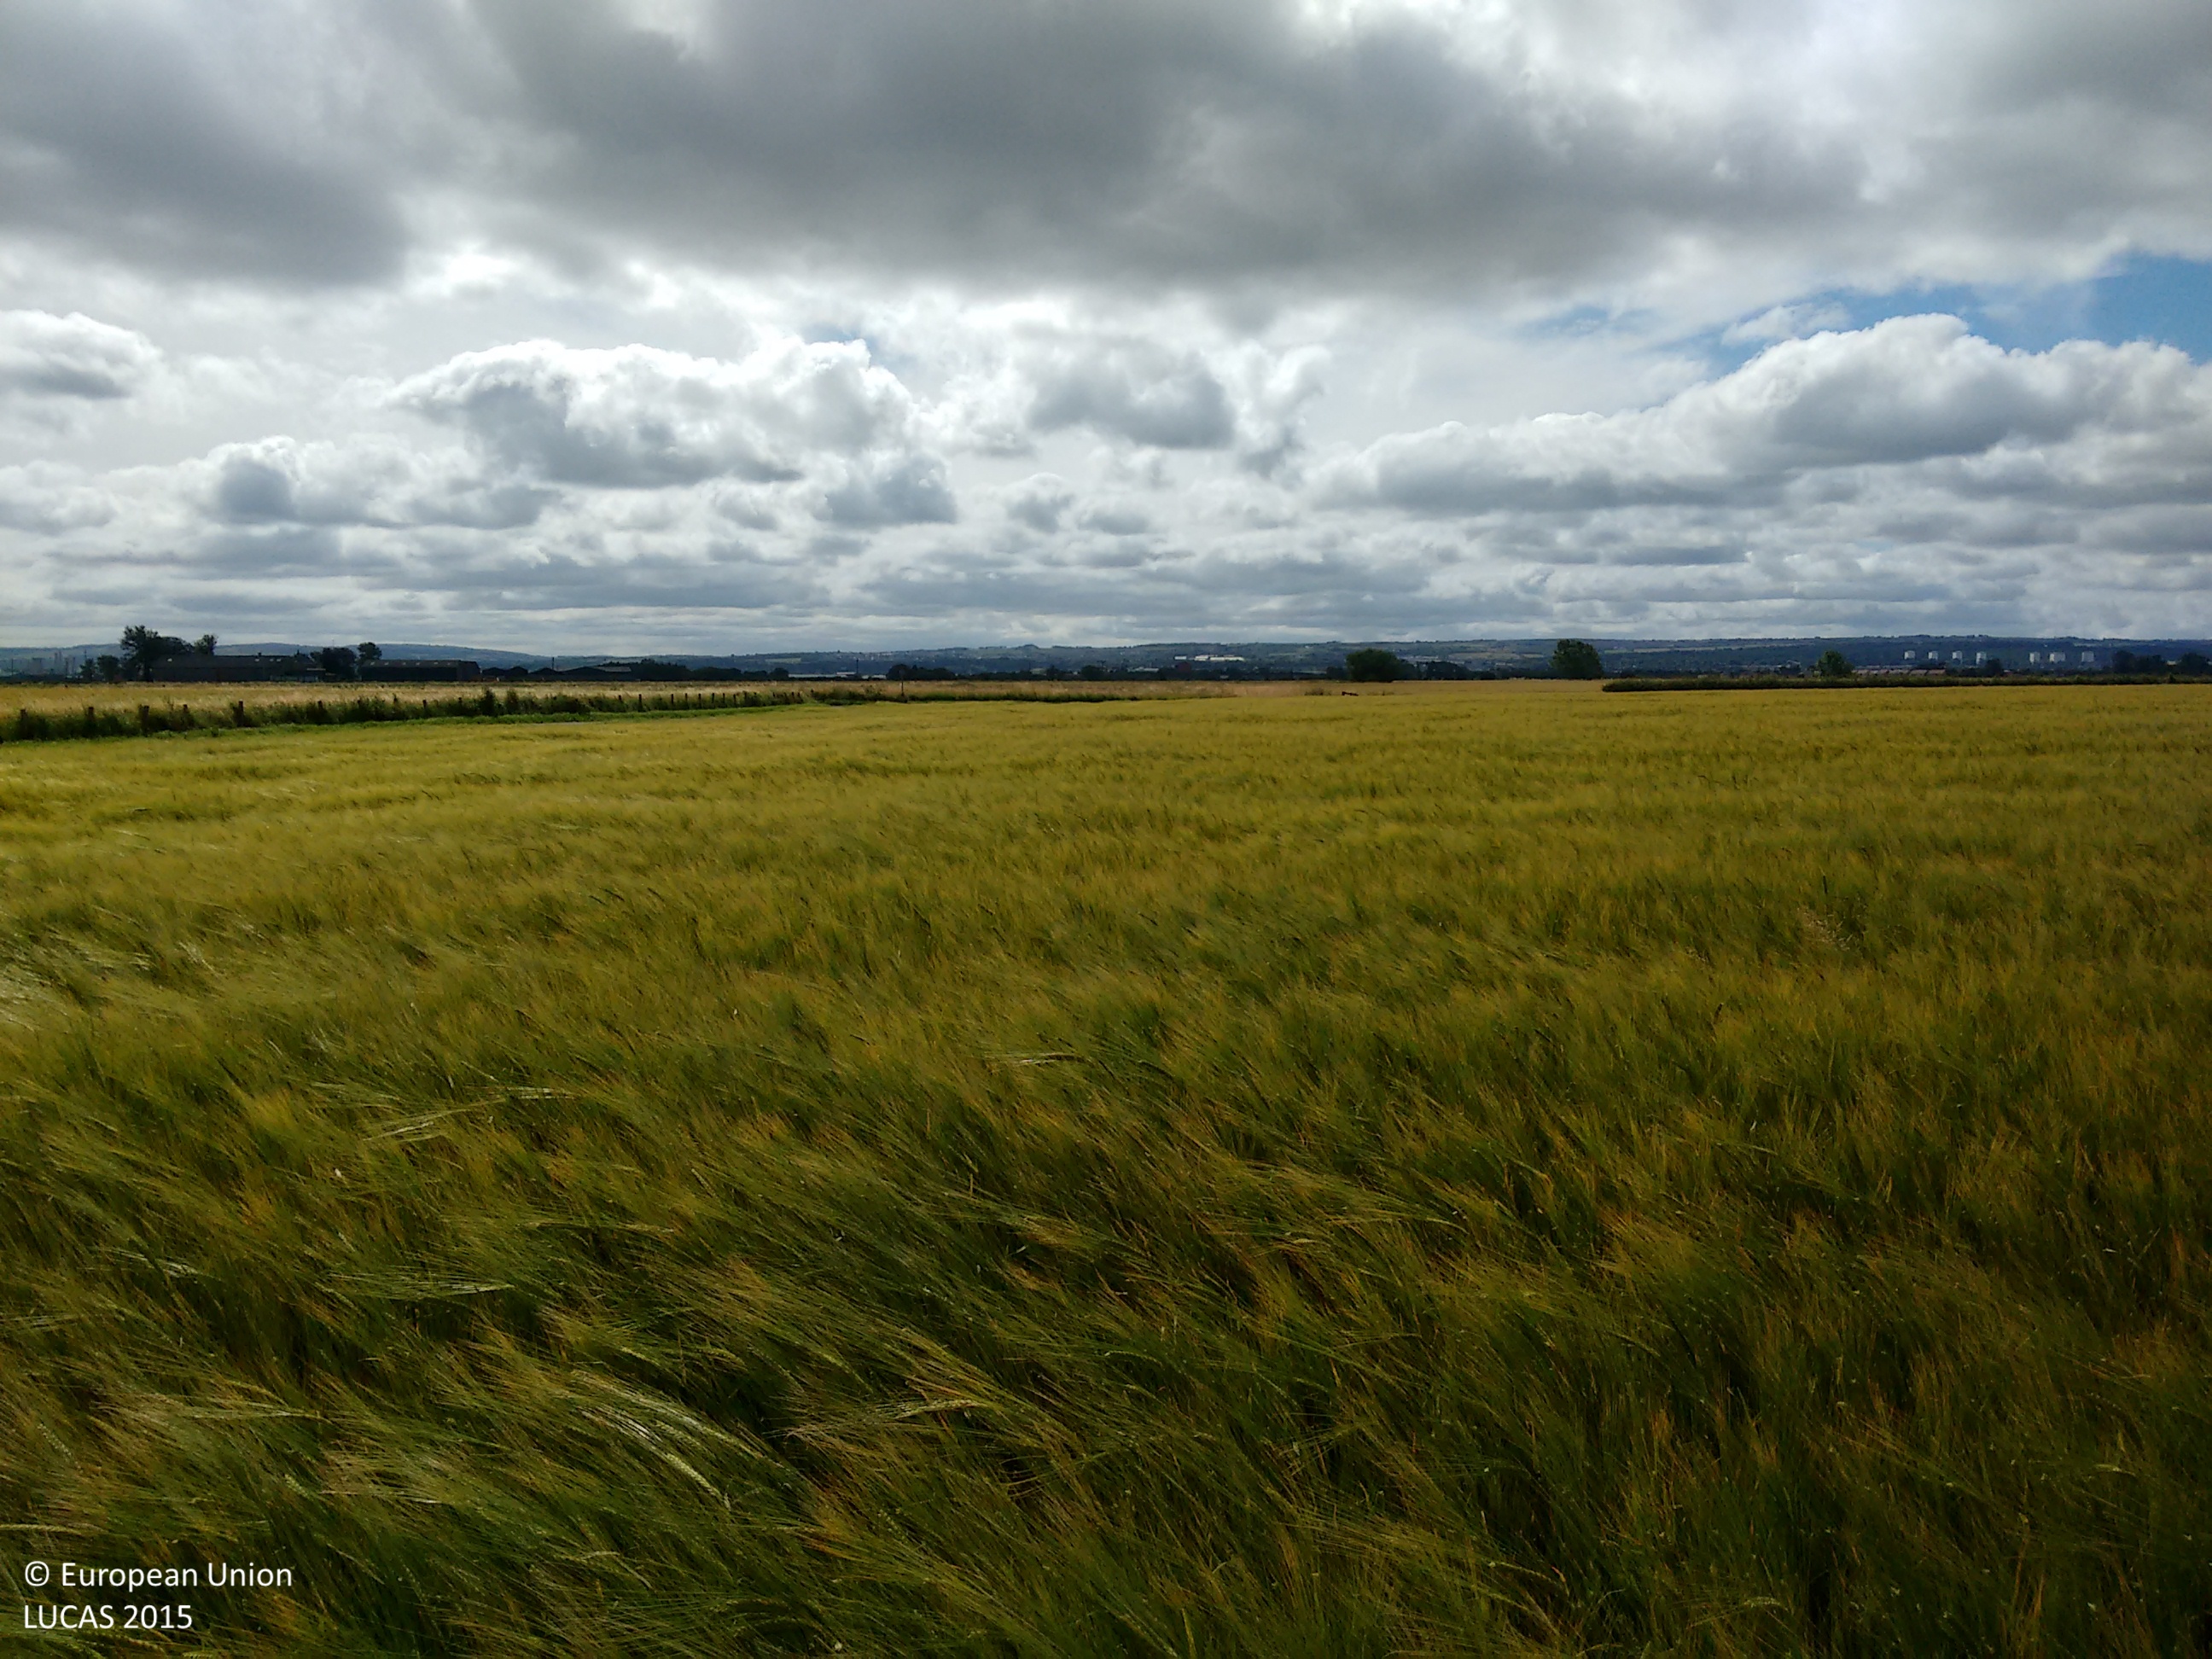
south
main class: Cropland
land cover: Barley
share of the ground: > 75 %
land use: Agriculture (excluding fallow land and kitchen gardens)
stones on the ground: < 10 %
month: August
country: GB
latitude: 56.0463
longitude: -3.7437
